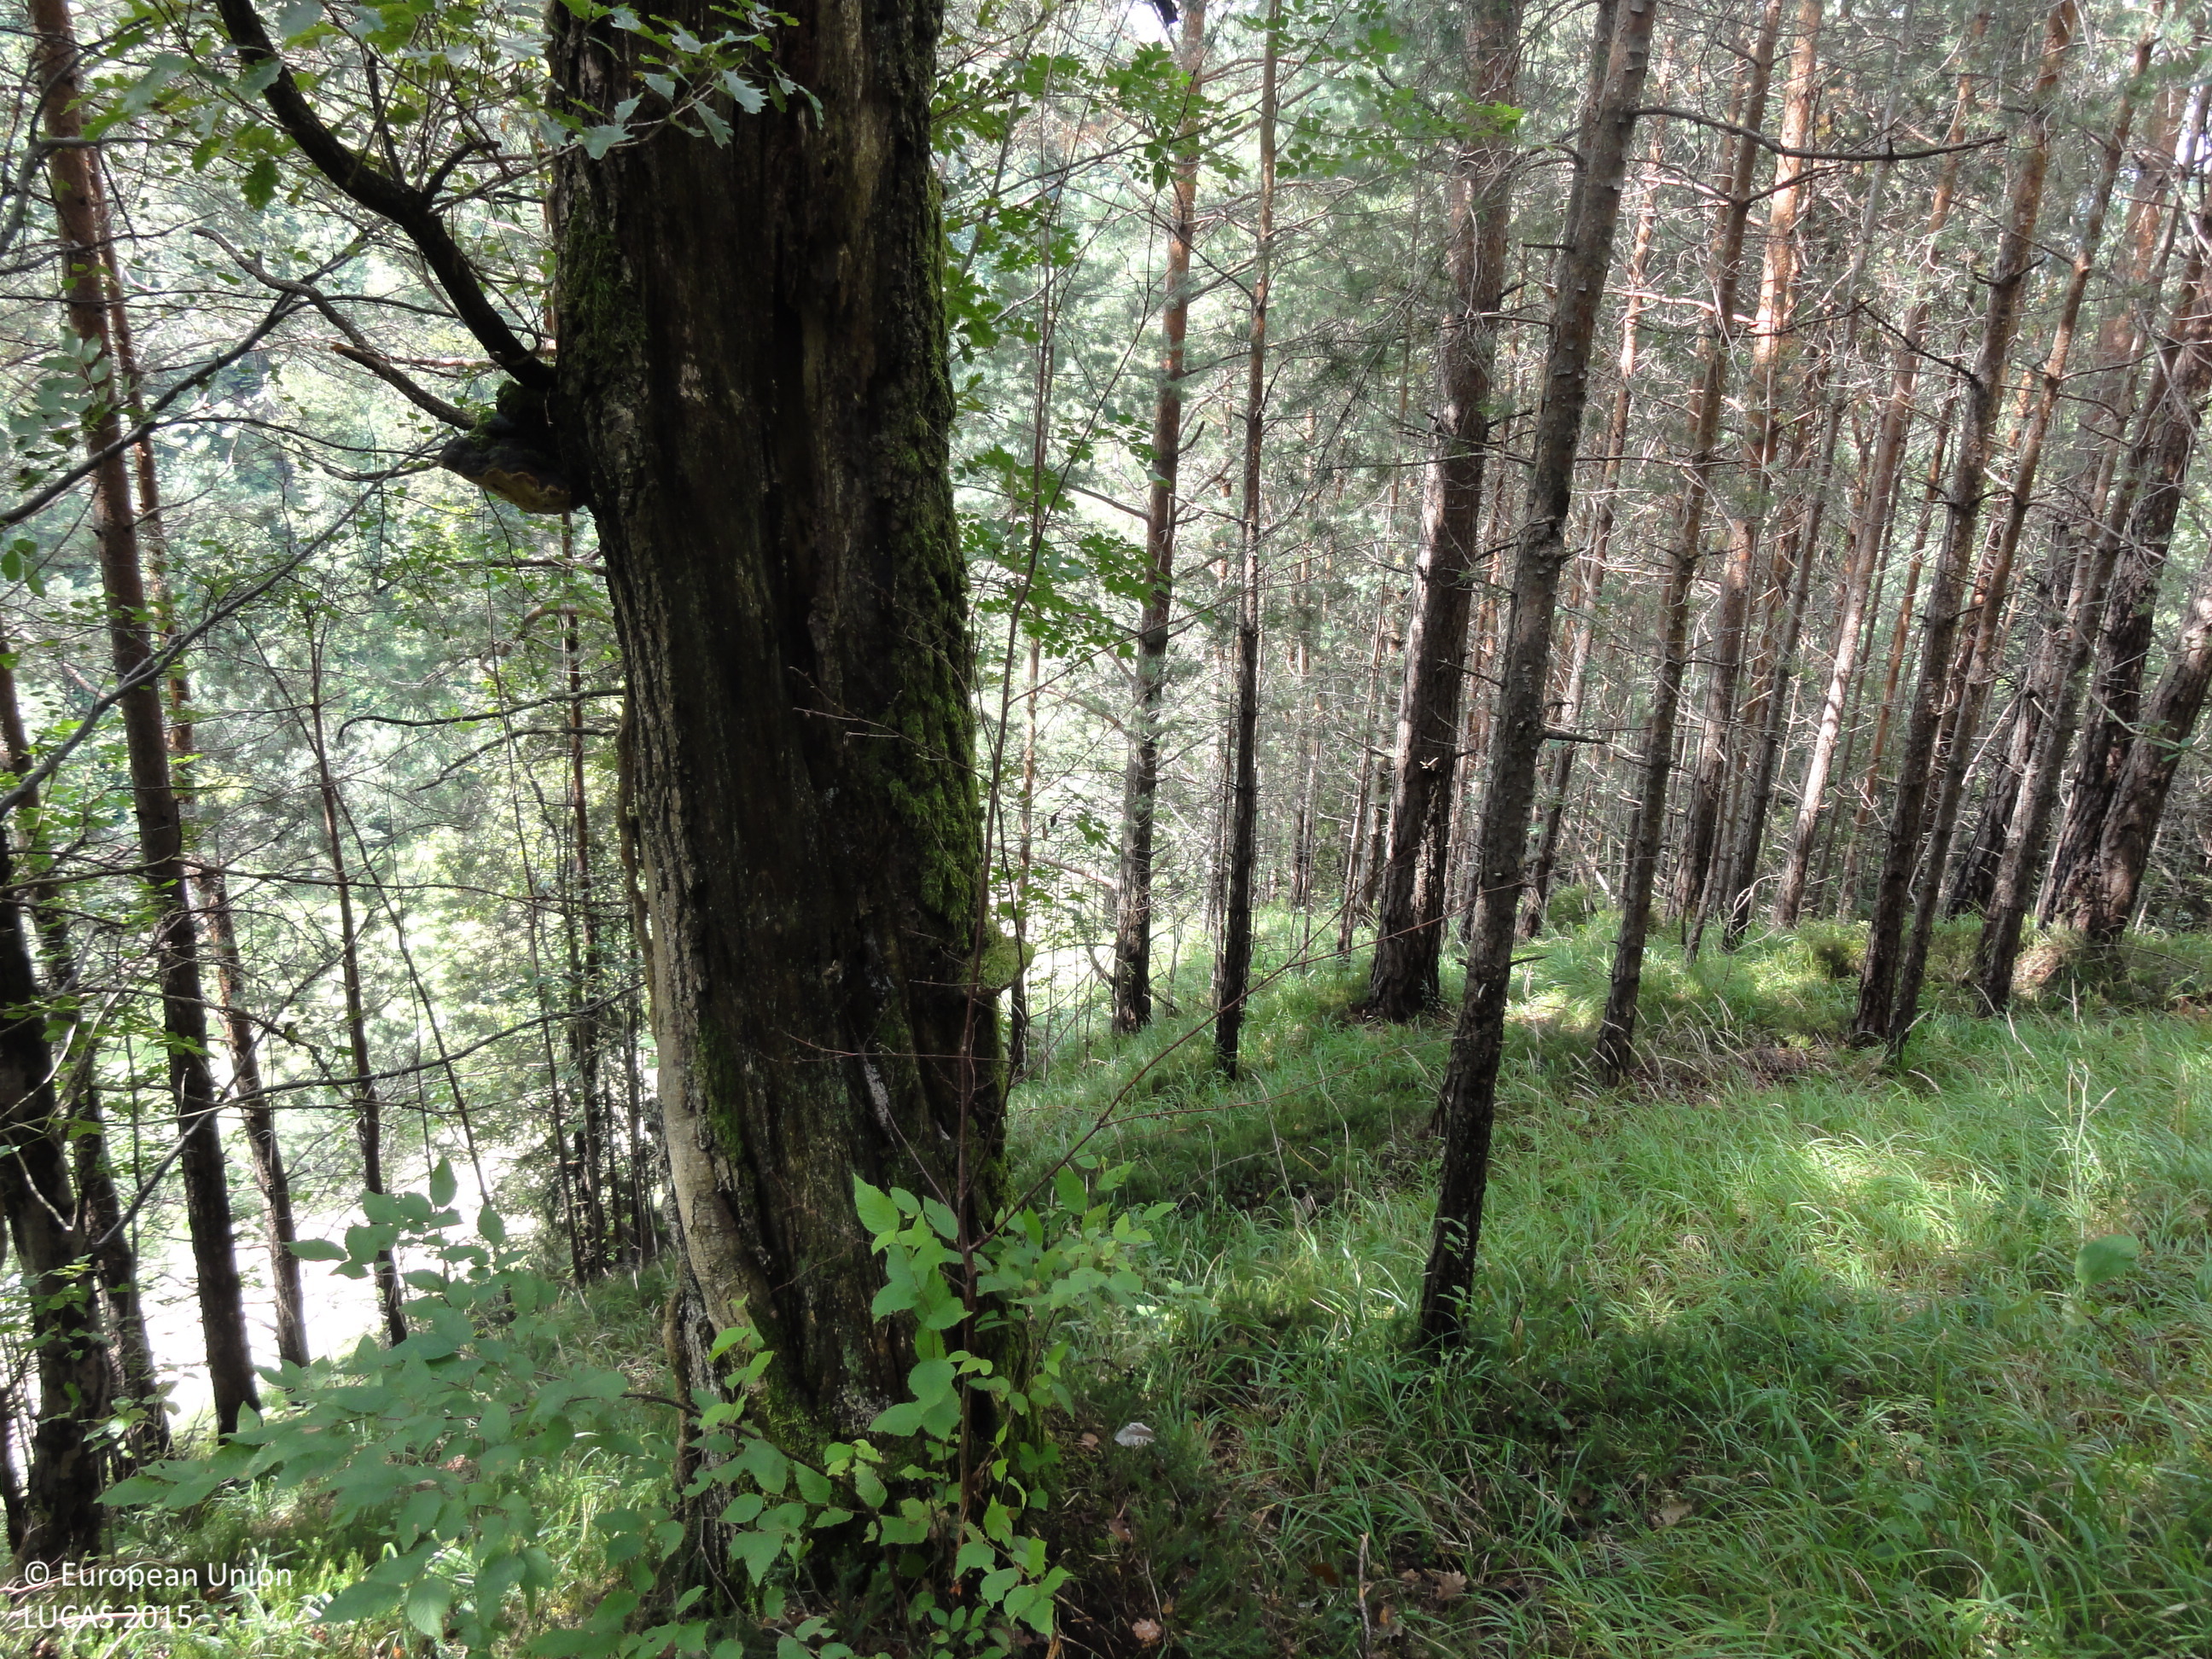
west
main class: Woodland
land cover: Pine dominated mixed woodland
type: hemiboreal forest and nemoral coniferous forest and mixed broadleaved-coniferous forest
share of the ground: > 75 %
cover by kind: coniferous forest trees 70 %, broadleaved forest trees 30 %
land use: Forestry
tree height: > 5 m
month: August
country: SI
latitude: 46.0886
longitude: 15.0280
